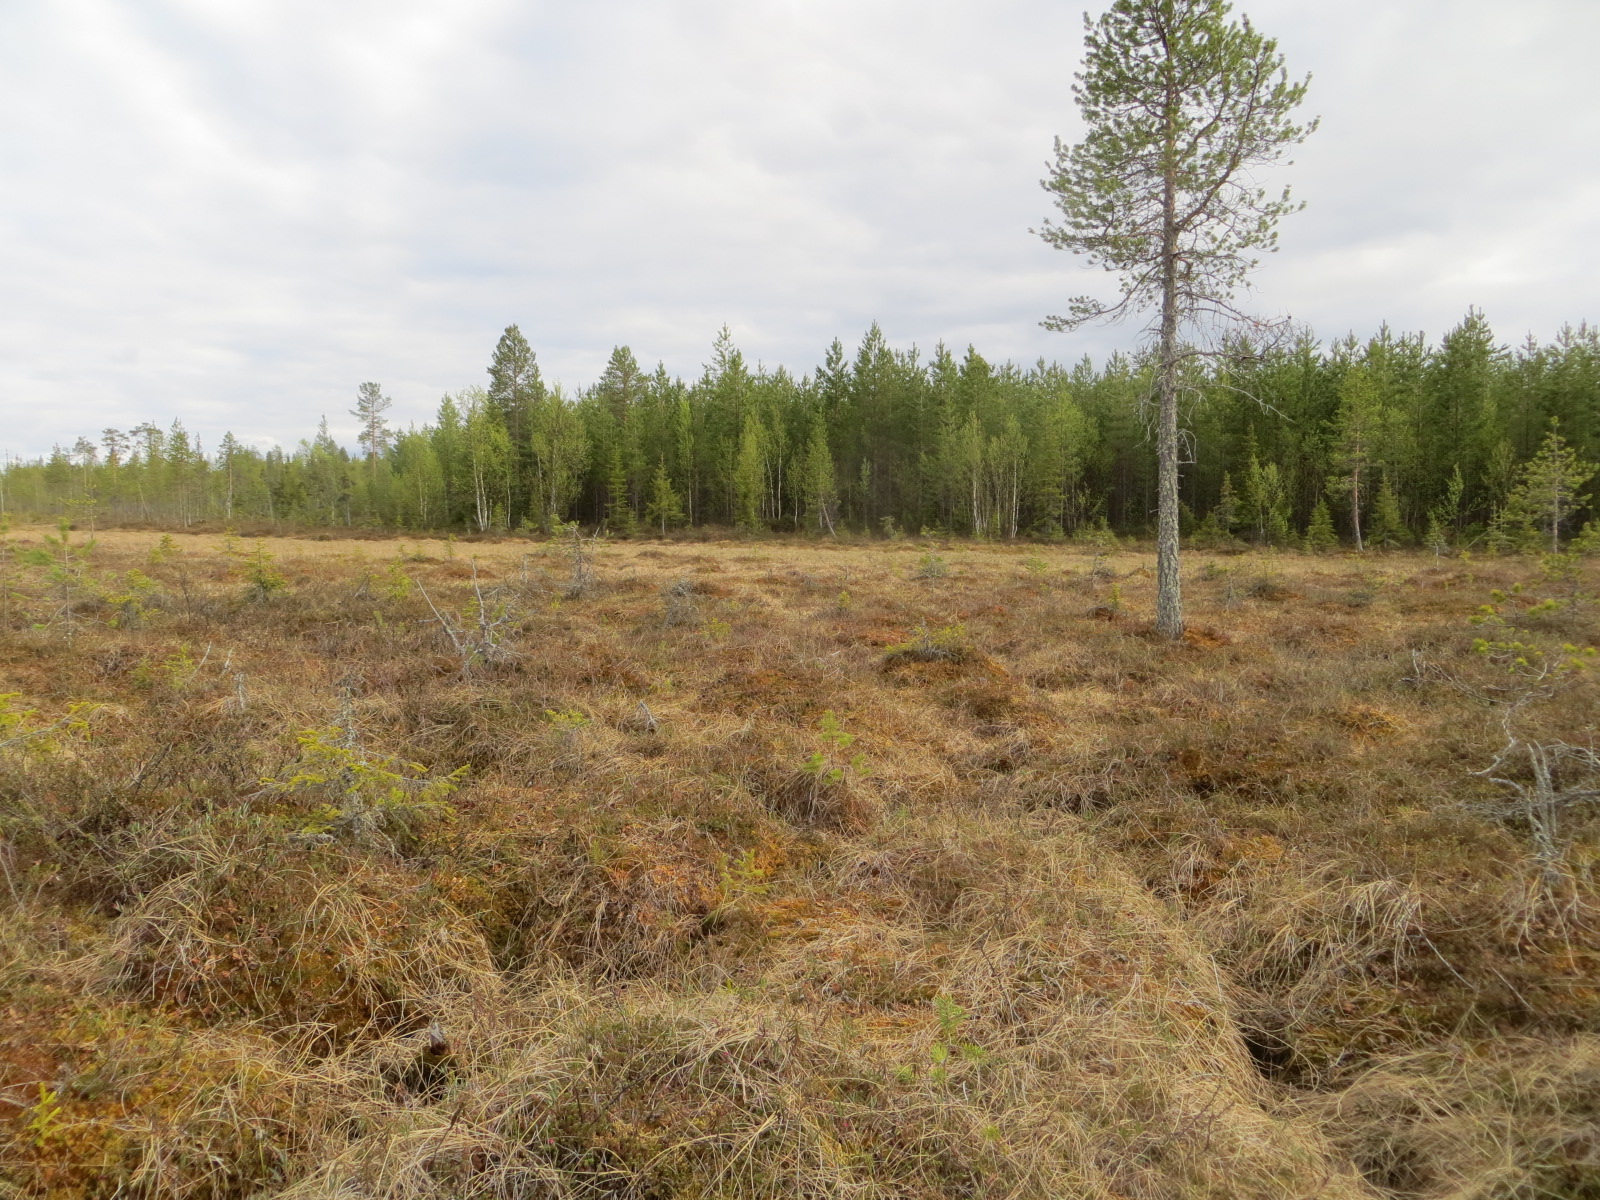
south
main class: Woodland
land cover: Pine dominated coniferous woodland
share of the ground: 25 - 50 %
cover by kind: coniferous forest trees 30 %, shrubs 30 %, herbaceous plants 30 %, lichens and mosses 10 %
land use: Semi-natural and natural areas not in use
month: June
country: FI
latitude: 67.1478
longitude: 24.8794
